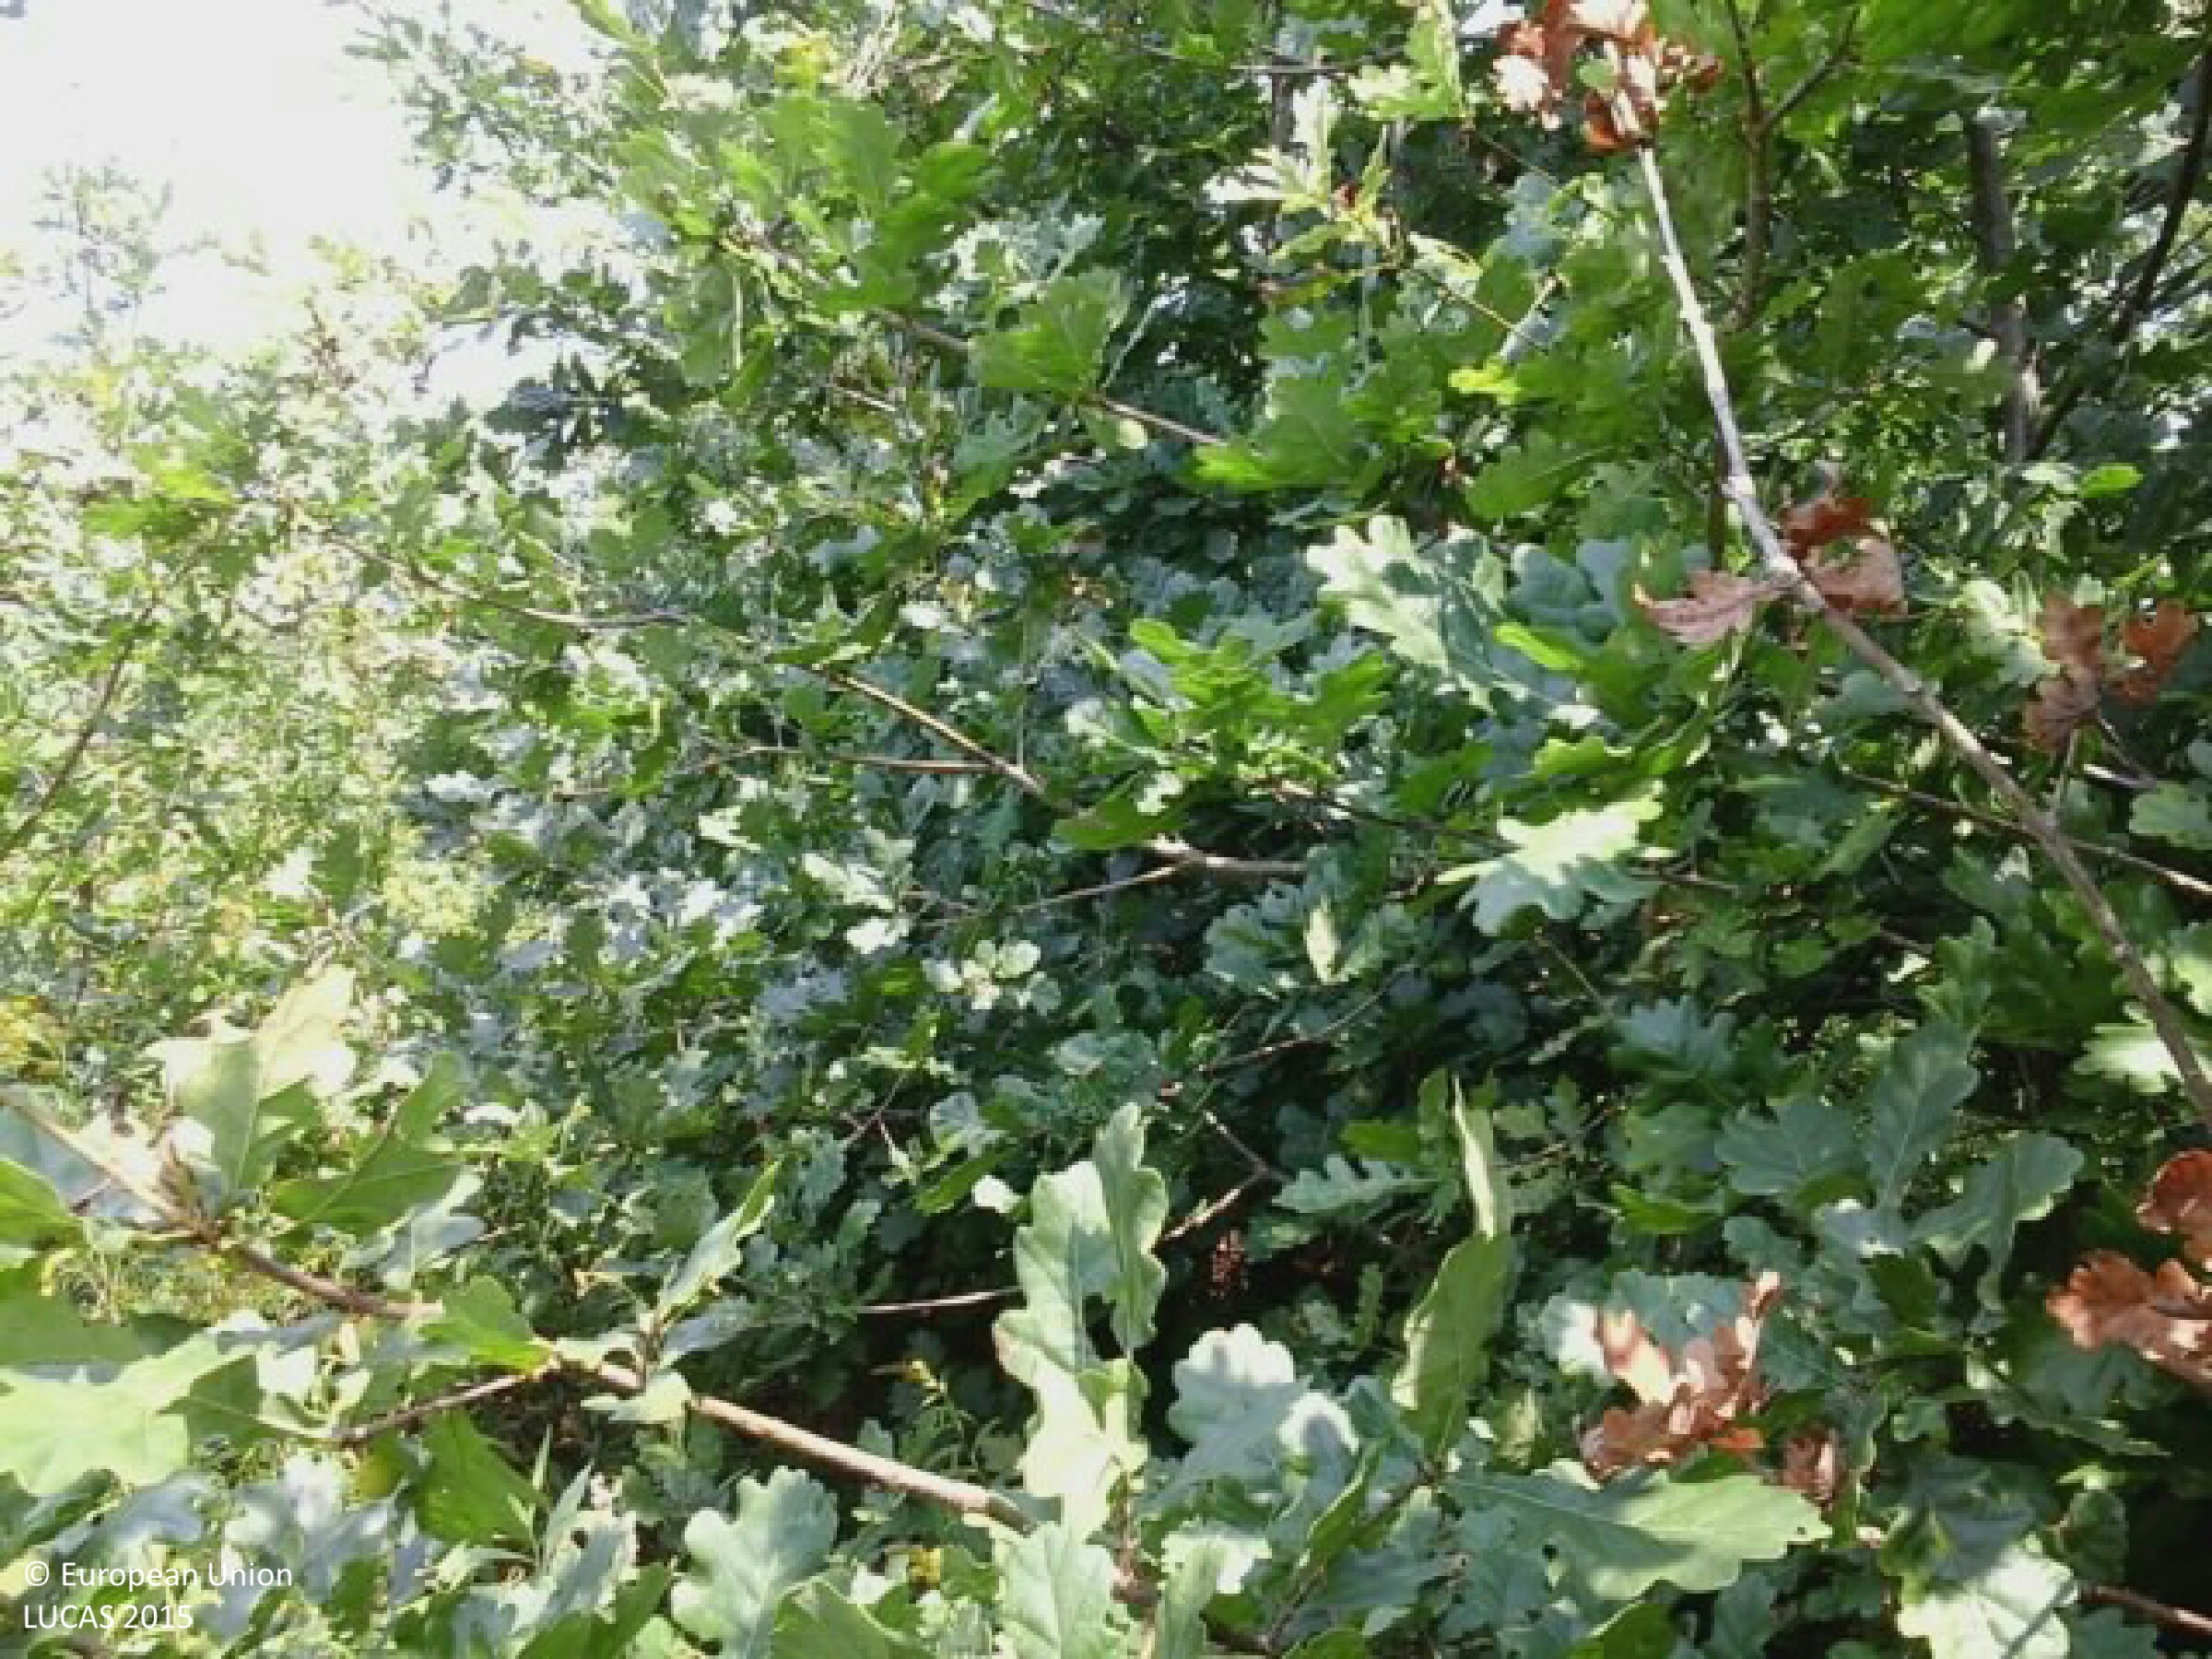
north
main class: Woodland
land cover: Broadleaved woodland
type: acidophilous oak and oak-birch forest
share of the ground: > 75 %
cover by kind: broadleaved forest trees 90 %, shrubs 5 %, herbaceous plants 5 %
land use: Forestry
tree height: > 5 m
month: August
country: HU
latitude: 46.3298
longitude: 17.1343
